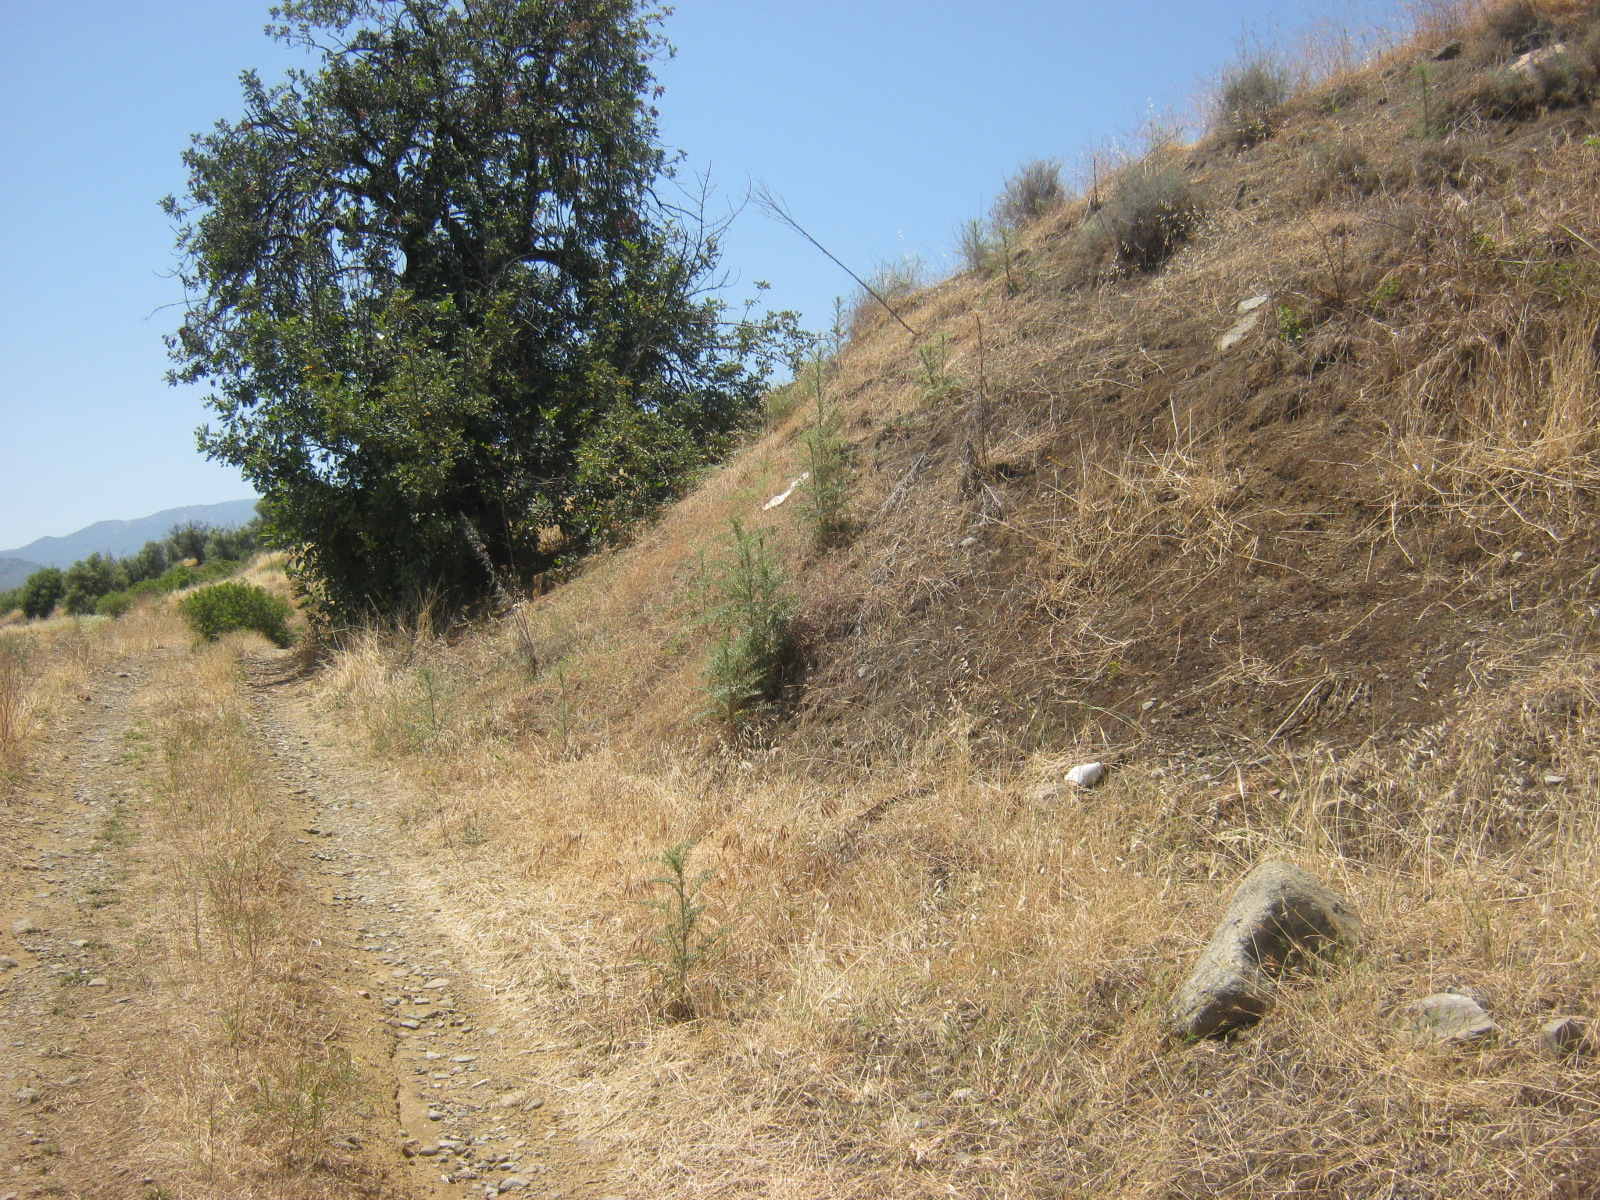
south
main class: Cropland
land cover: Olive groves
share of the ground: 50 - 75 %
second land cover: Grassland without tree/shrub cover
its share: > 75 %
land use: Agriculture (excluding fallow land and kitchen gardens)
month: May
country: CY
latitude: 35.0678
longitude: 32.8817
